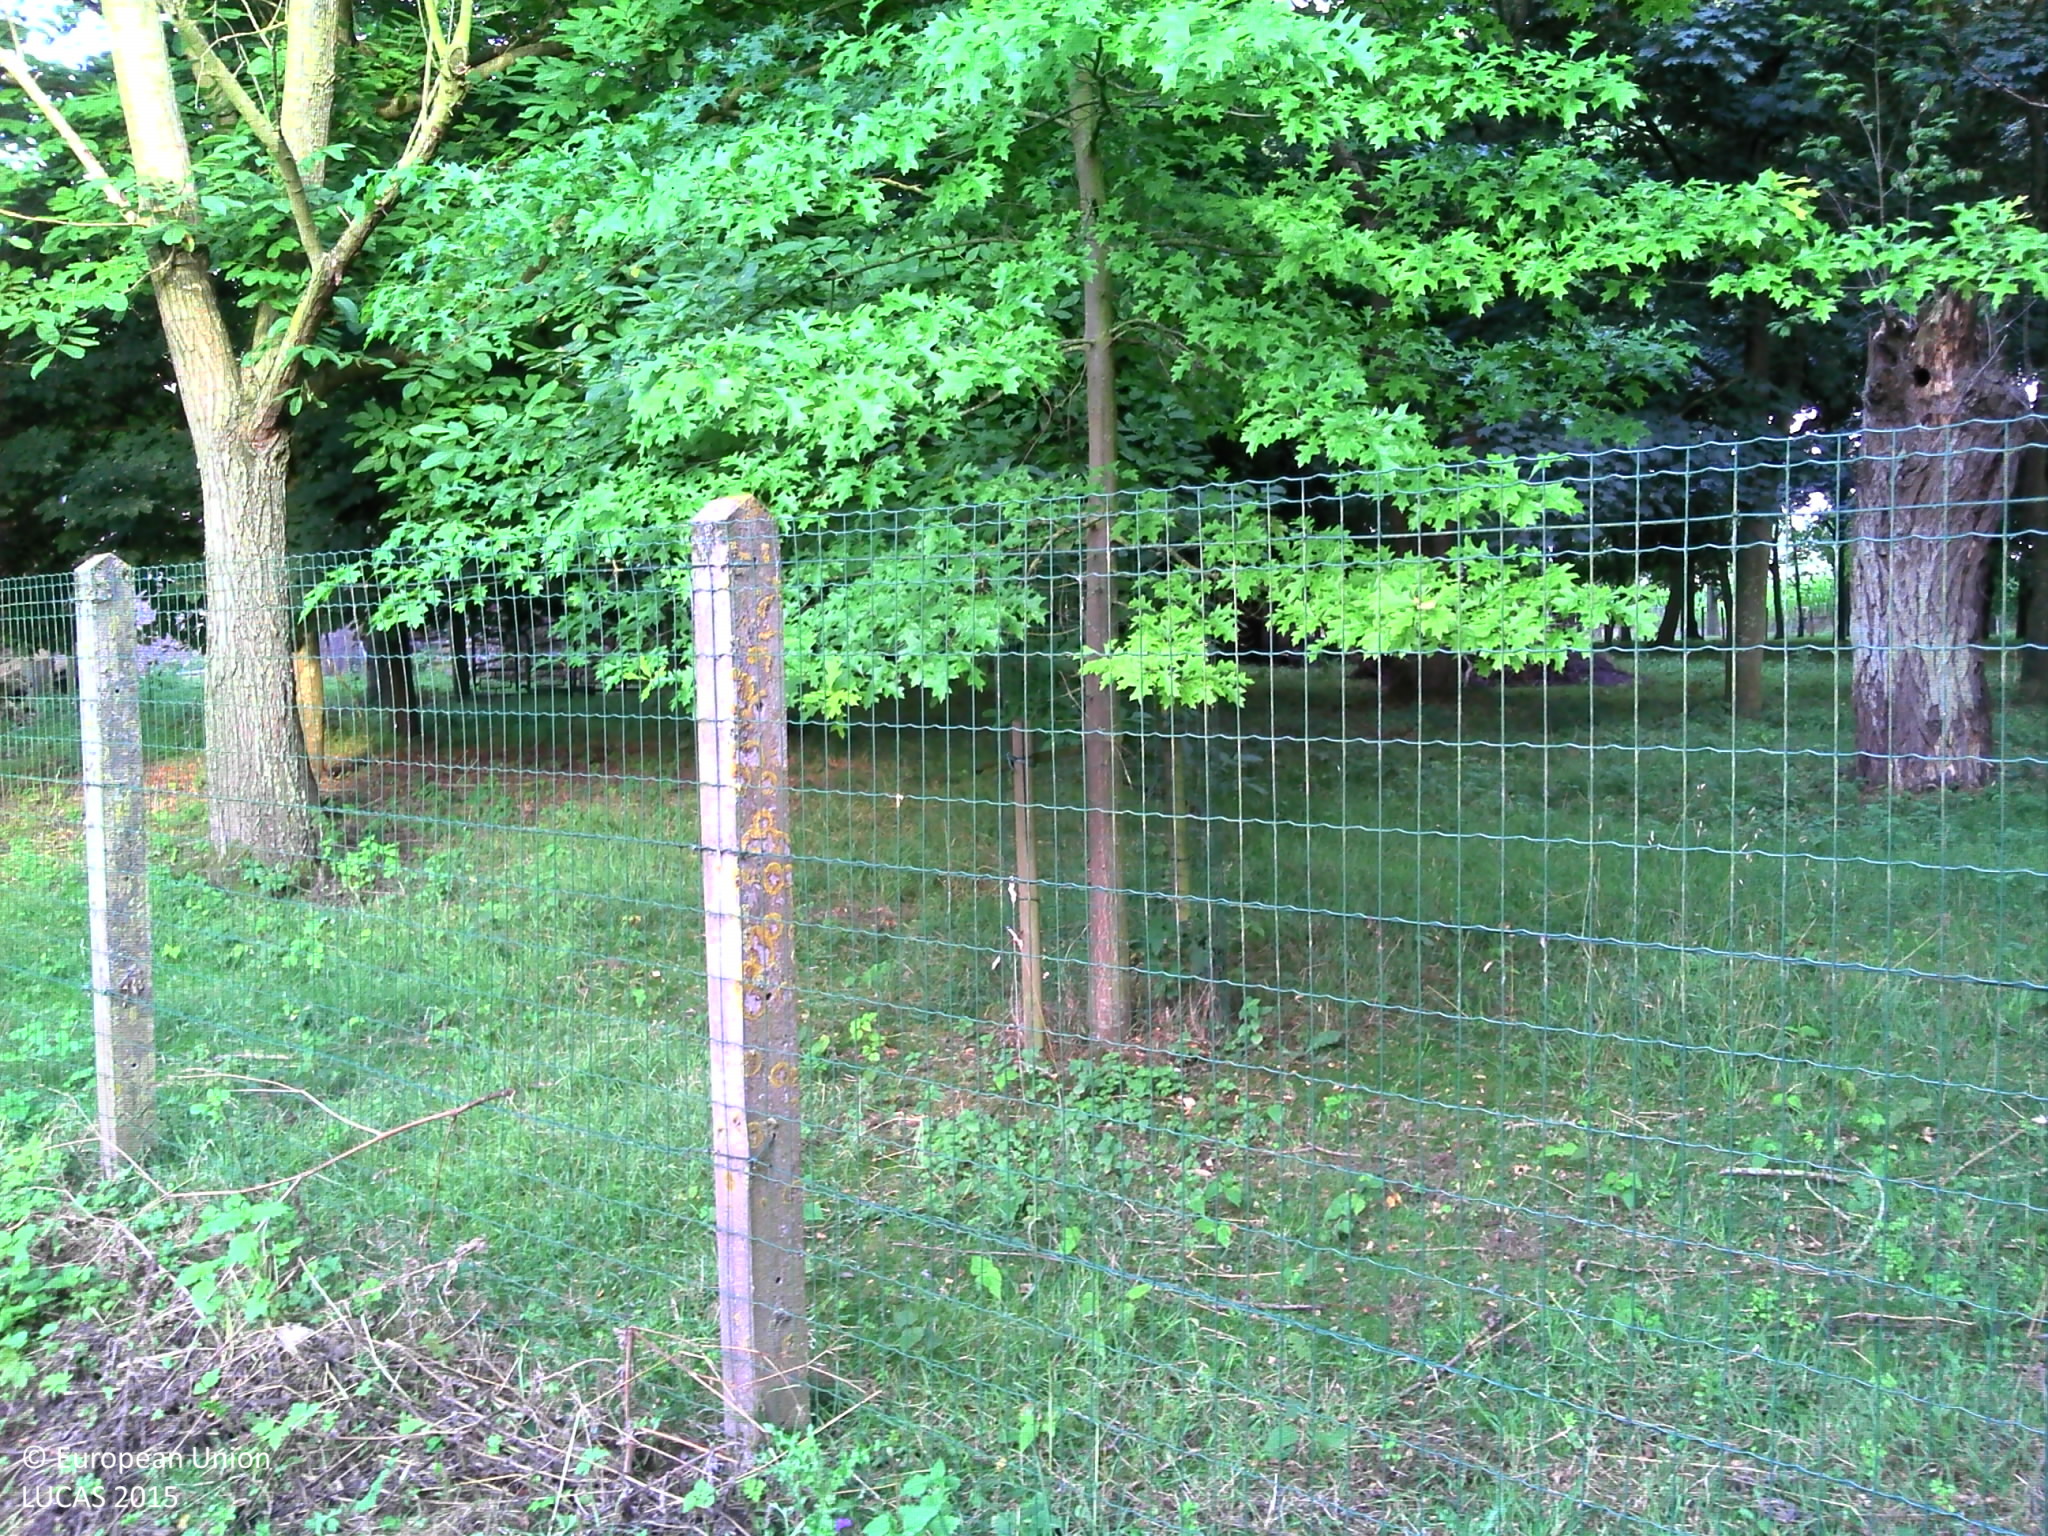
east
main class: Woodland
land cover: Broadleaved woodland
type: acidophilous oak and oak-birch forest
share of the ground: > 75 %
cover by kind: broadleaved forest trees 85 %, herbaceous plants 10 %, lichens and mosses 5 %
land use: Residential
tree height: > 5 m
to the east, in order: Broadleaved woodland; Fences; Maize; Electric lines; Maize; Artificial constructions in urban areas; Common wheat; Grass margins; Fences; Grassland without tree/shrub cover; Fences; Broadleaved woodland
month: July
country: FR
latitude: 50.7470
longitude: 3.0313
